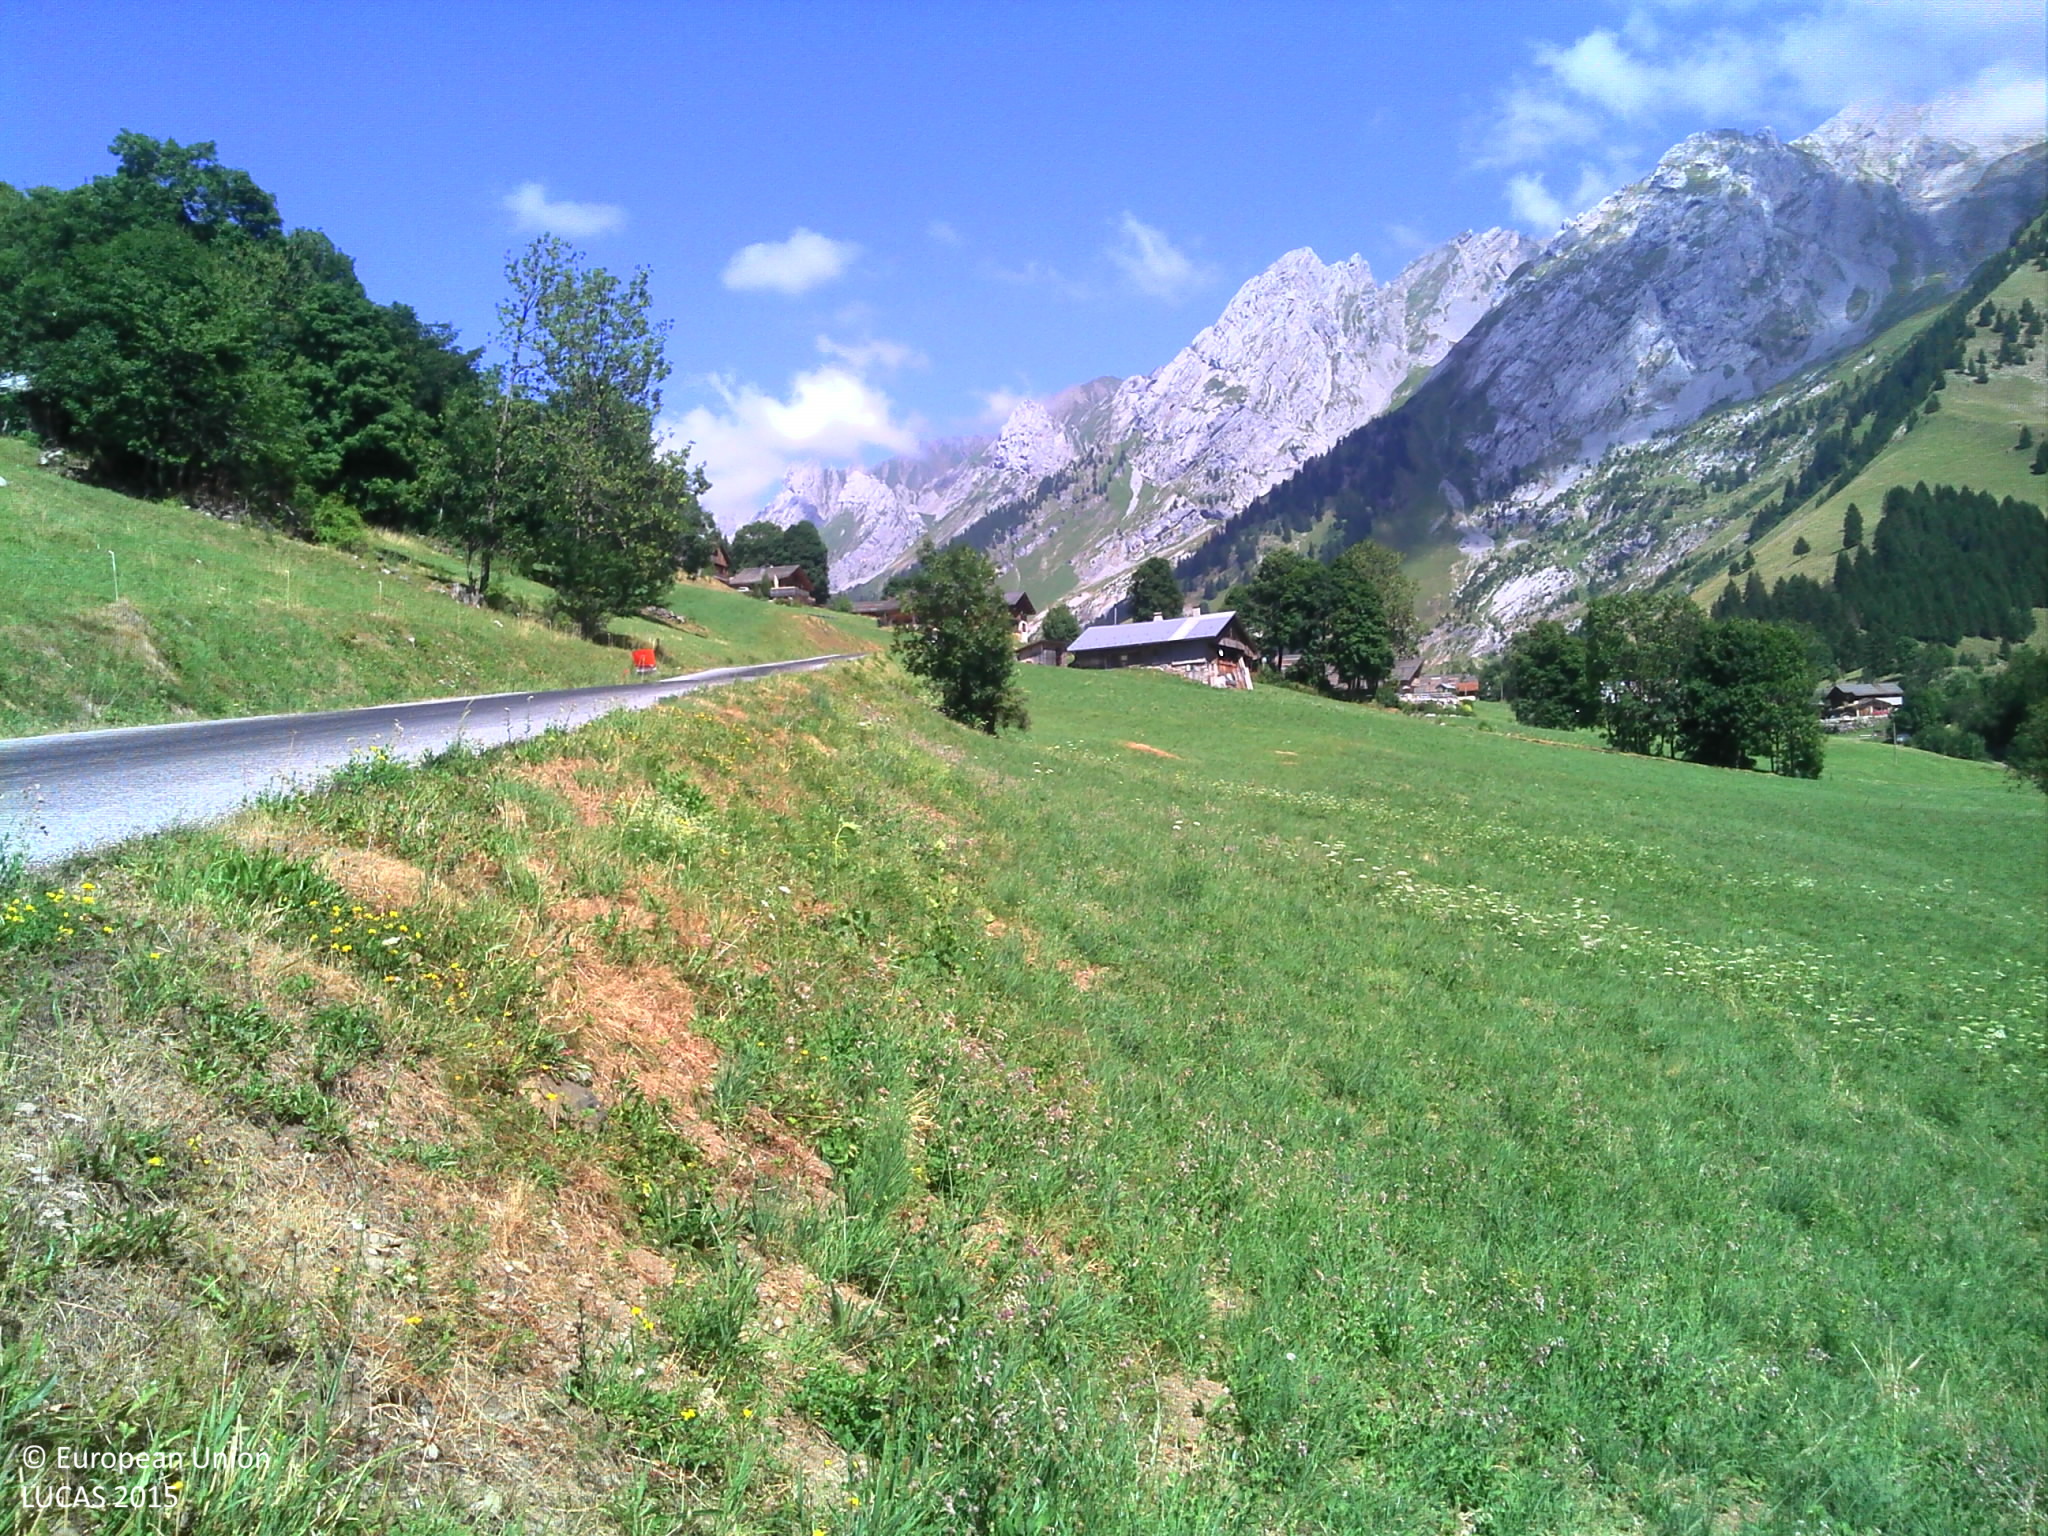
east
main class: Grassland
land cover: Grassland with sparse tree/shrub cover
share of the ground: > 75 %
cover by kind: herbaceous plants 95 %, broadleaved forest trees 5 %
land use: Agriculture (excluding fallow land and kitchen gardens)
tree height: > 5 m
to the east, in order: Grassland with sparse tree/shrub cover; Dry stone walls; Tracks; Dry stone walls; Lines of trees; Ditches and canals; Grassland without tree/shrub cover
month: July
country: FR
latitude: 45.9139
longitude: 6.4585
